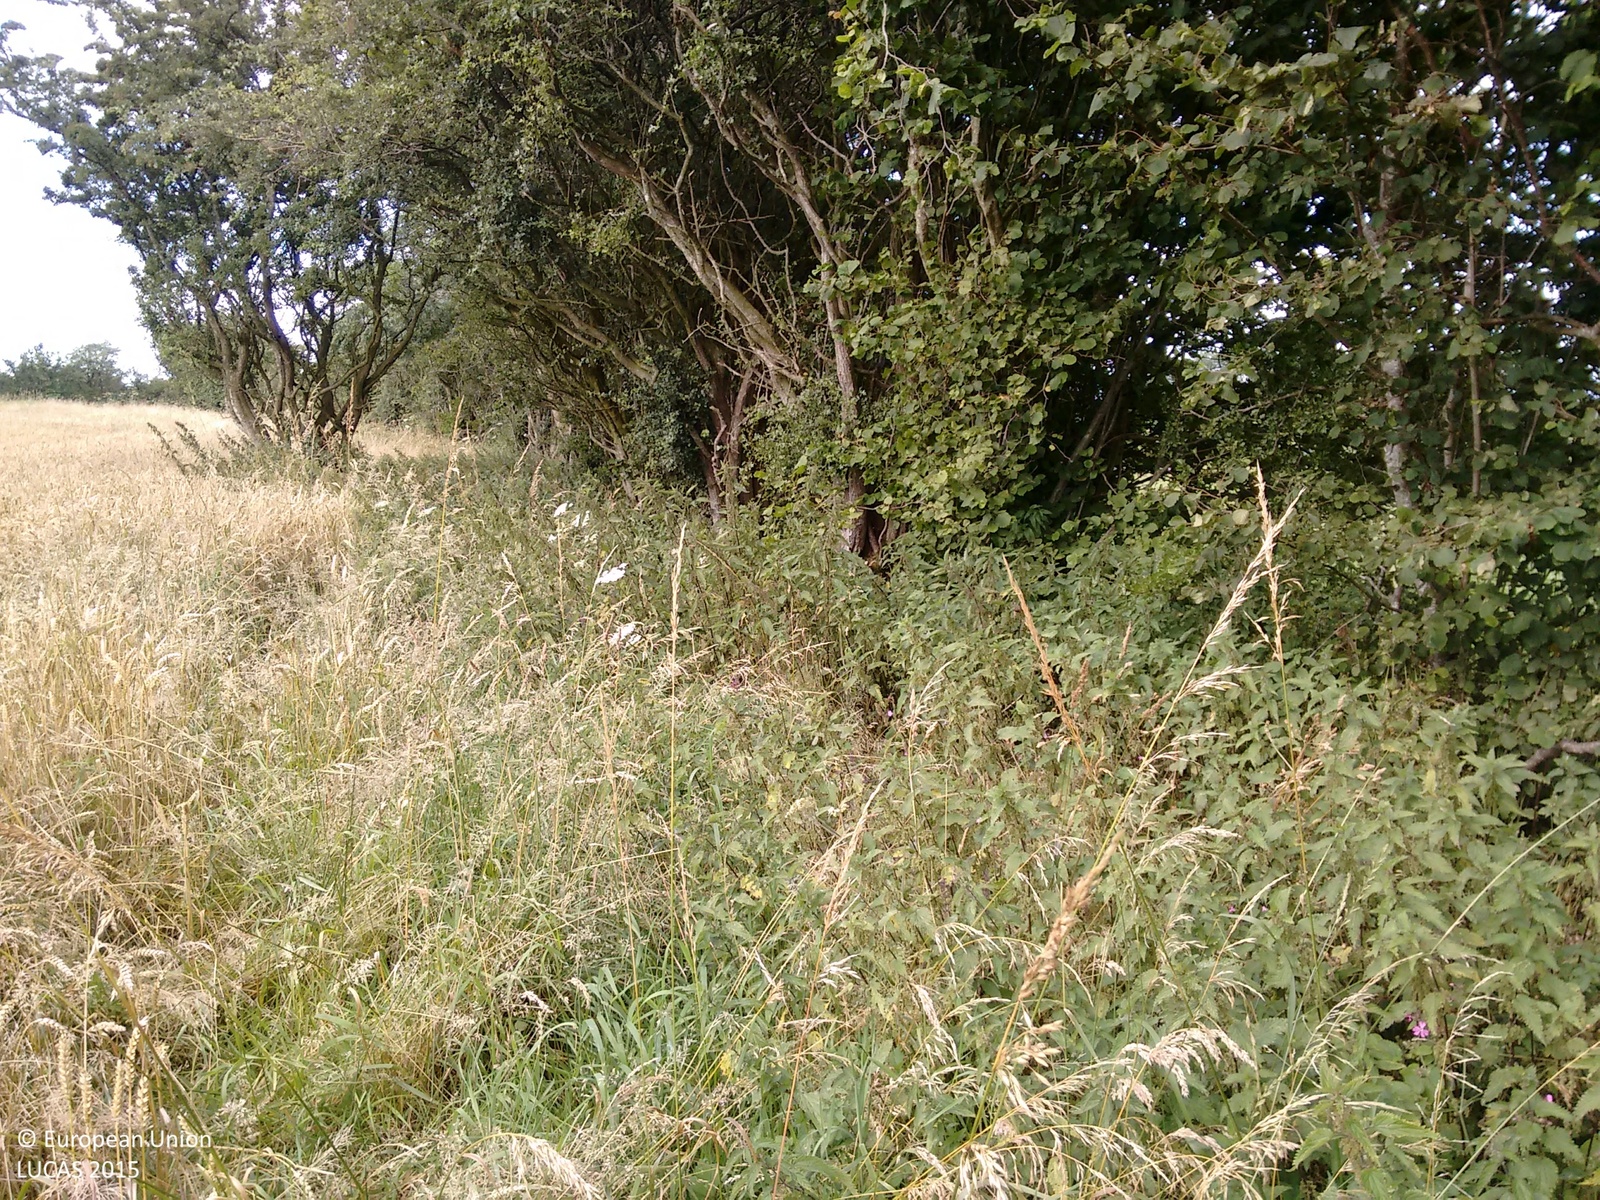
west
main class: Grassland
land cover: Grassland without tree/shrub cover
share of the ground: > 75 %
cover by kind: herbaceous plants 100 %
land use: Agriculture (excluding fallow land and kitchen gardens)
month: August
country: GB
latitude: 54.7160
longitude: -3.3827
